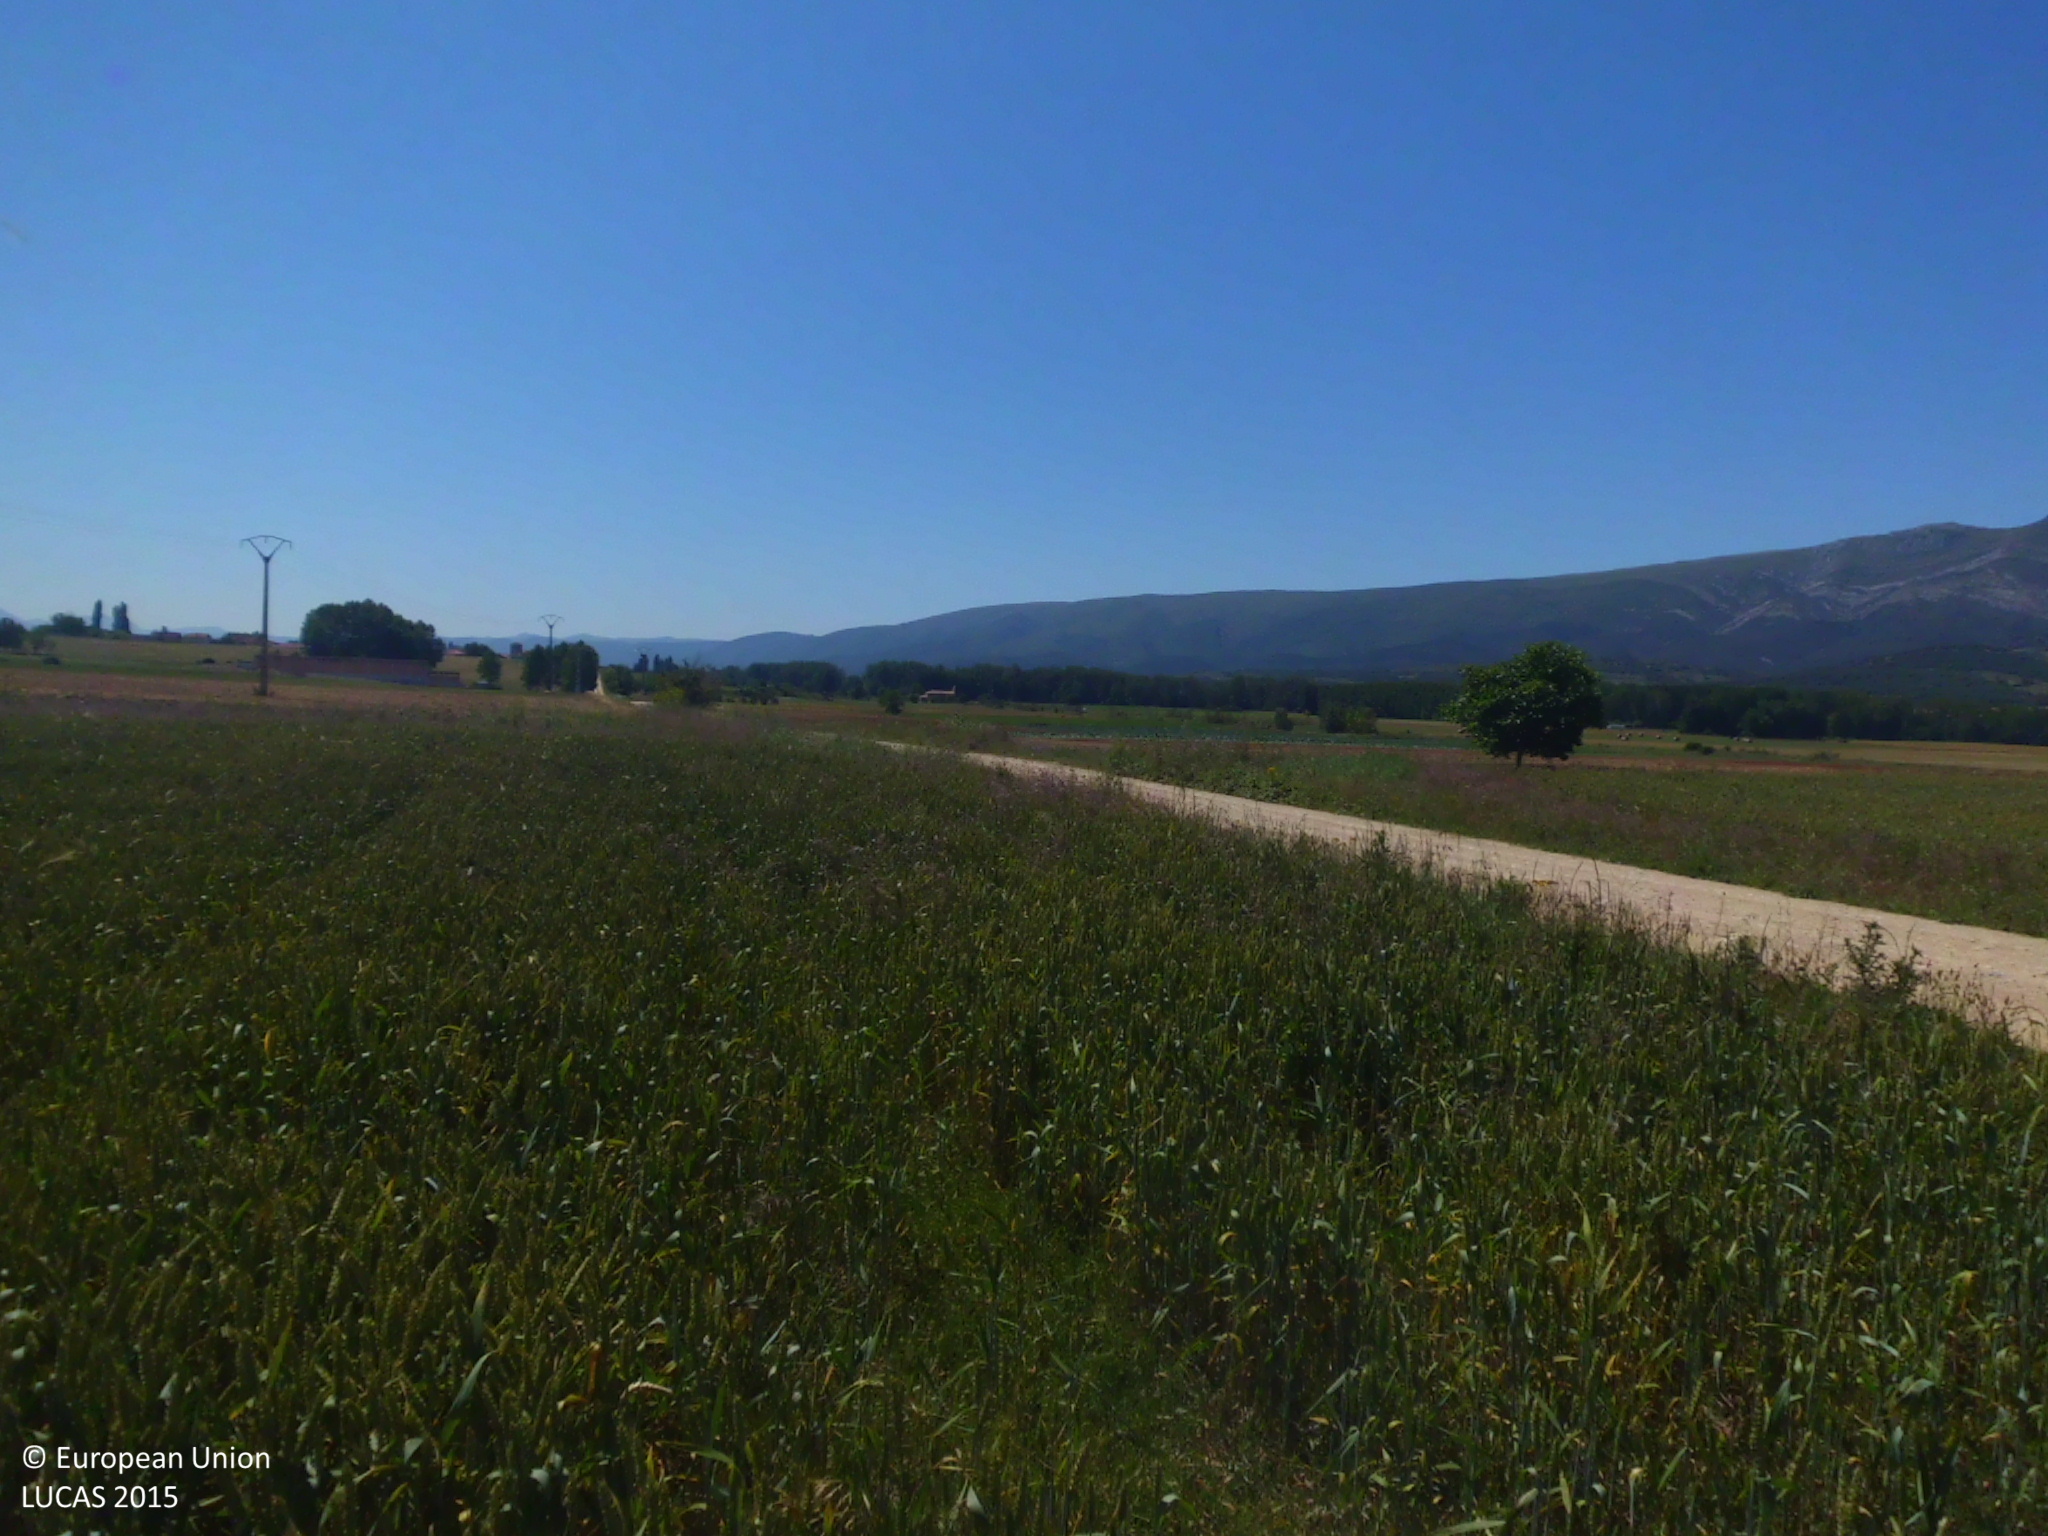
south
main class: Cropland
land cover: Common wheat
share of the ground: > 75 %
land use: Agriculture (excluding fallow land and kitchen gardens)
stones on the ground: < 10 %
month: June
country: ES
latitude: 42.9008
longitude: -3.4735
